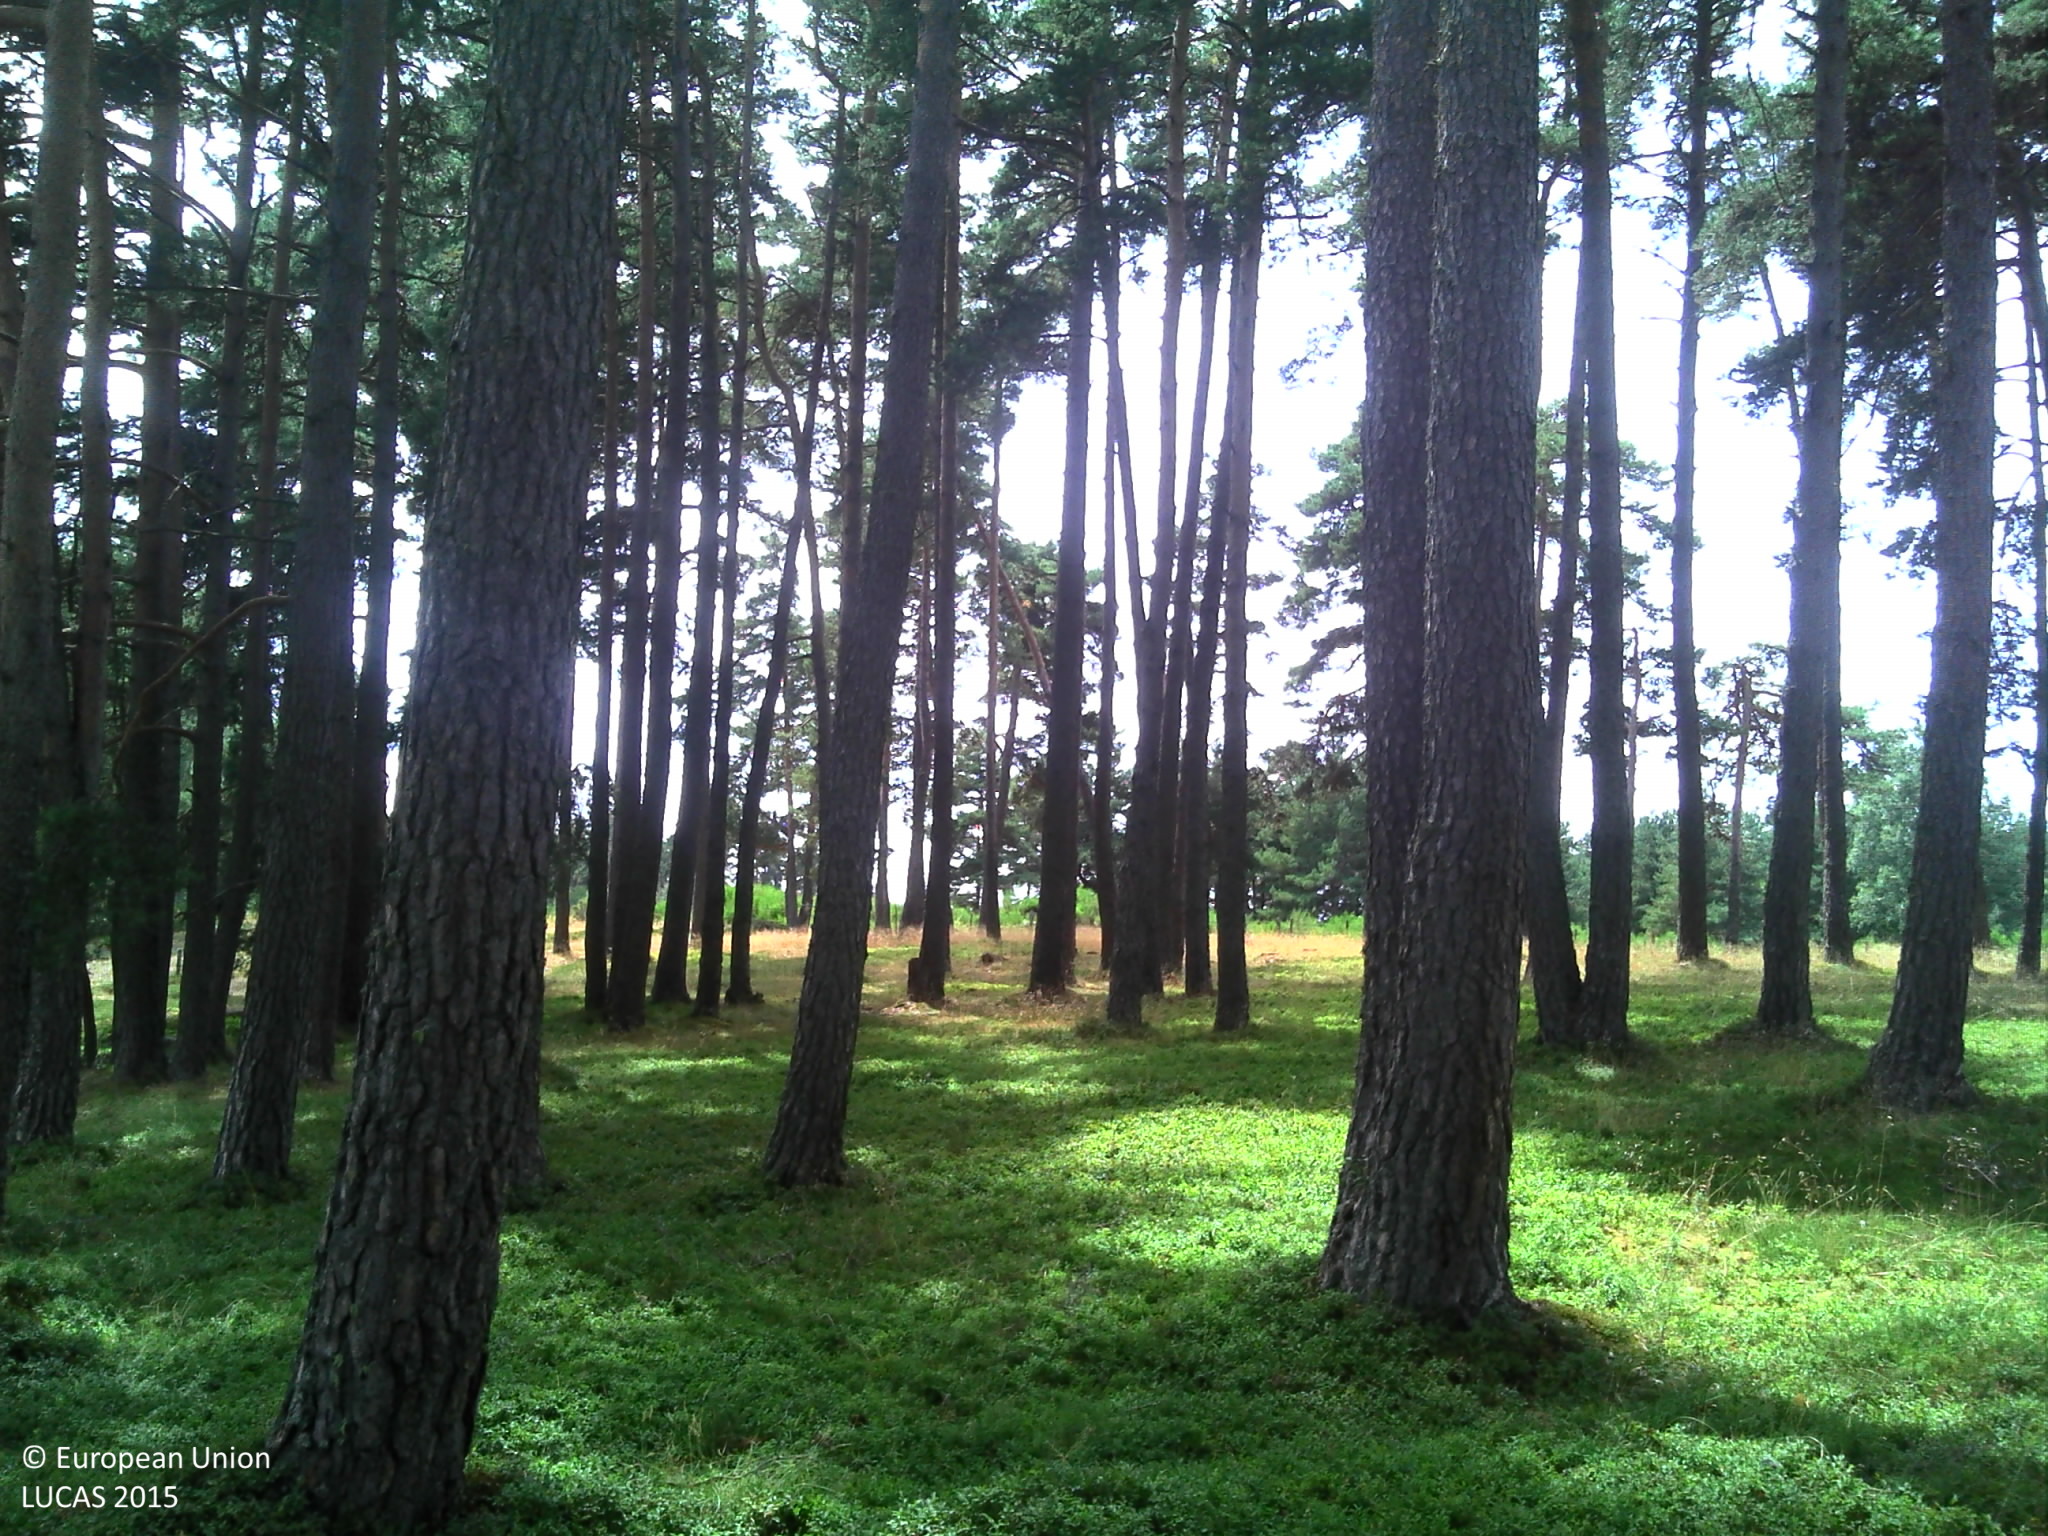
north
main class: Woodland
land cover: Pine dominated coniferous woodland
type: hemiboreal forest and nemoral coniferous forest and mixed broadleaved-coniferous forest
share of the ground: > 75 %
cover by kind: coniferous forest trees 95 %, broadleaved forest trees 5 %
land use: Forestry
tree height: > 5 m
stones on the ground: 10 - 25 %
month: July
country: FR
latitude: 44.8483
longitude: 3.1581
